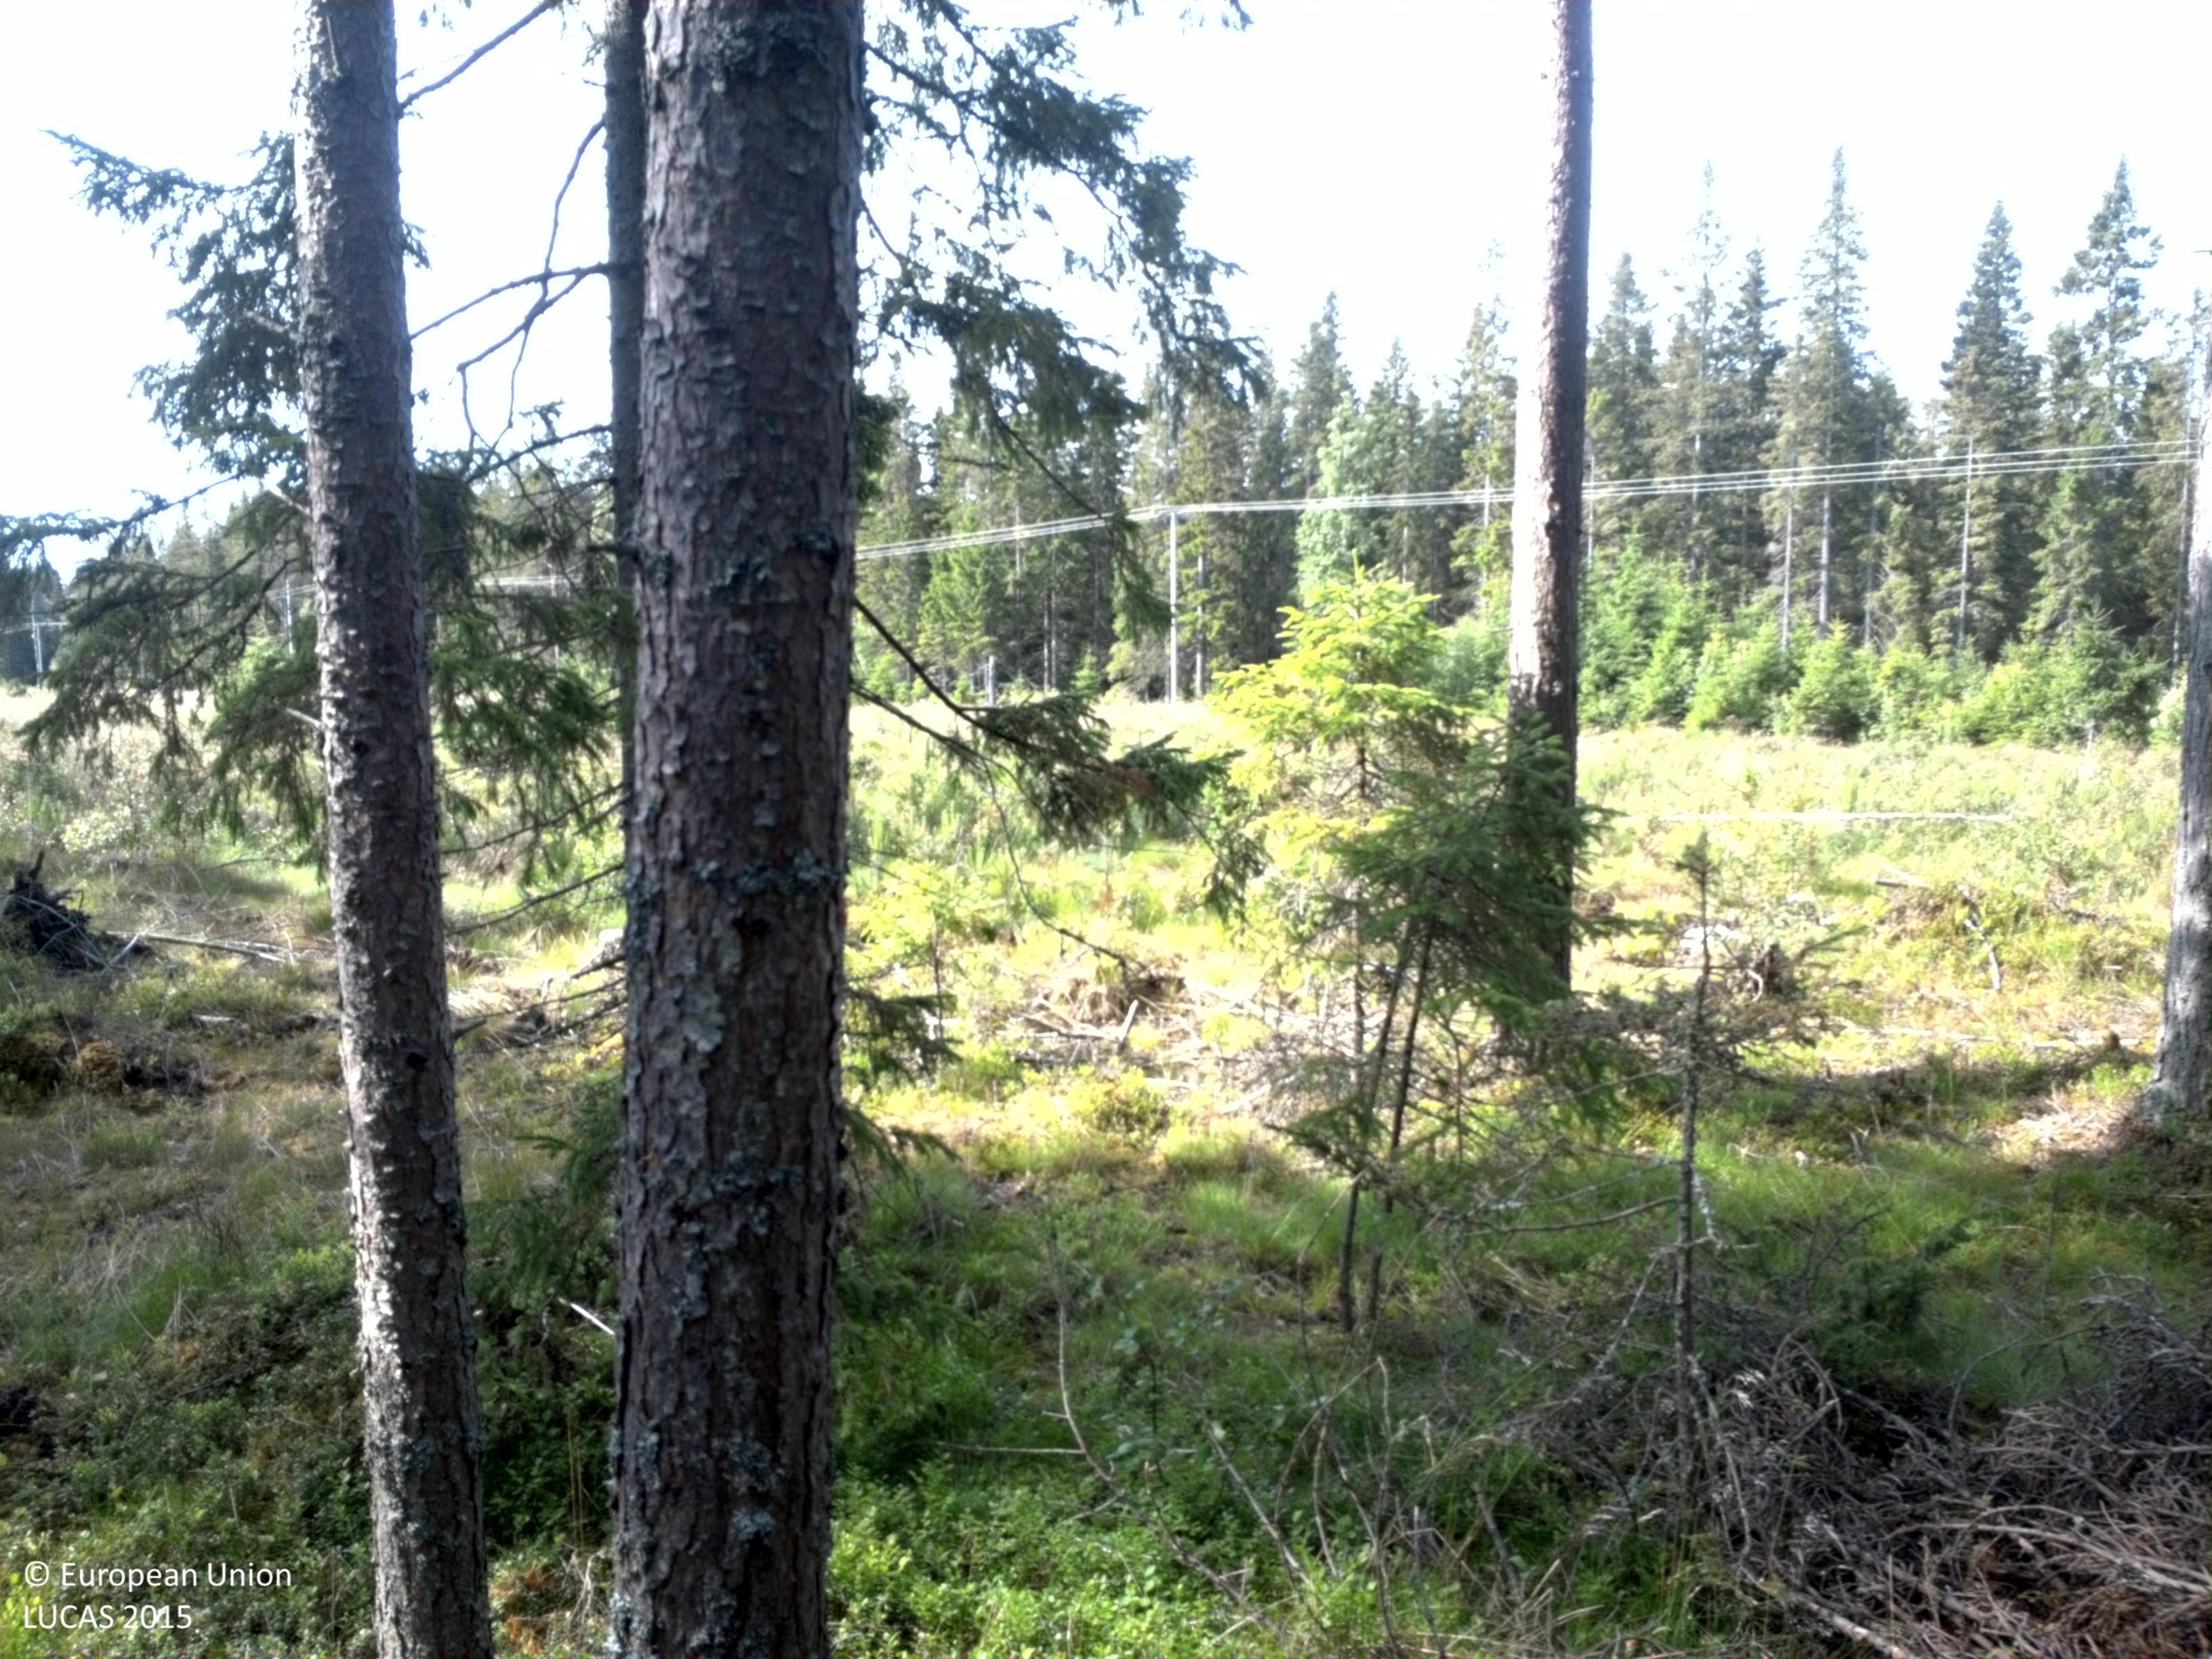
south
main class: Woodland
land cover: Pine dominated coniferous woodland
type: boreal forest
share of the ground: 50 - 75 %
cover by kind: coniferous forest trees 65 %, shrubs 35 %
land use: Forestry
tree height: > 5 m
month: July
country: SE
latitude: 64.4499
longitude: 21.5611
